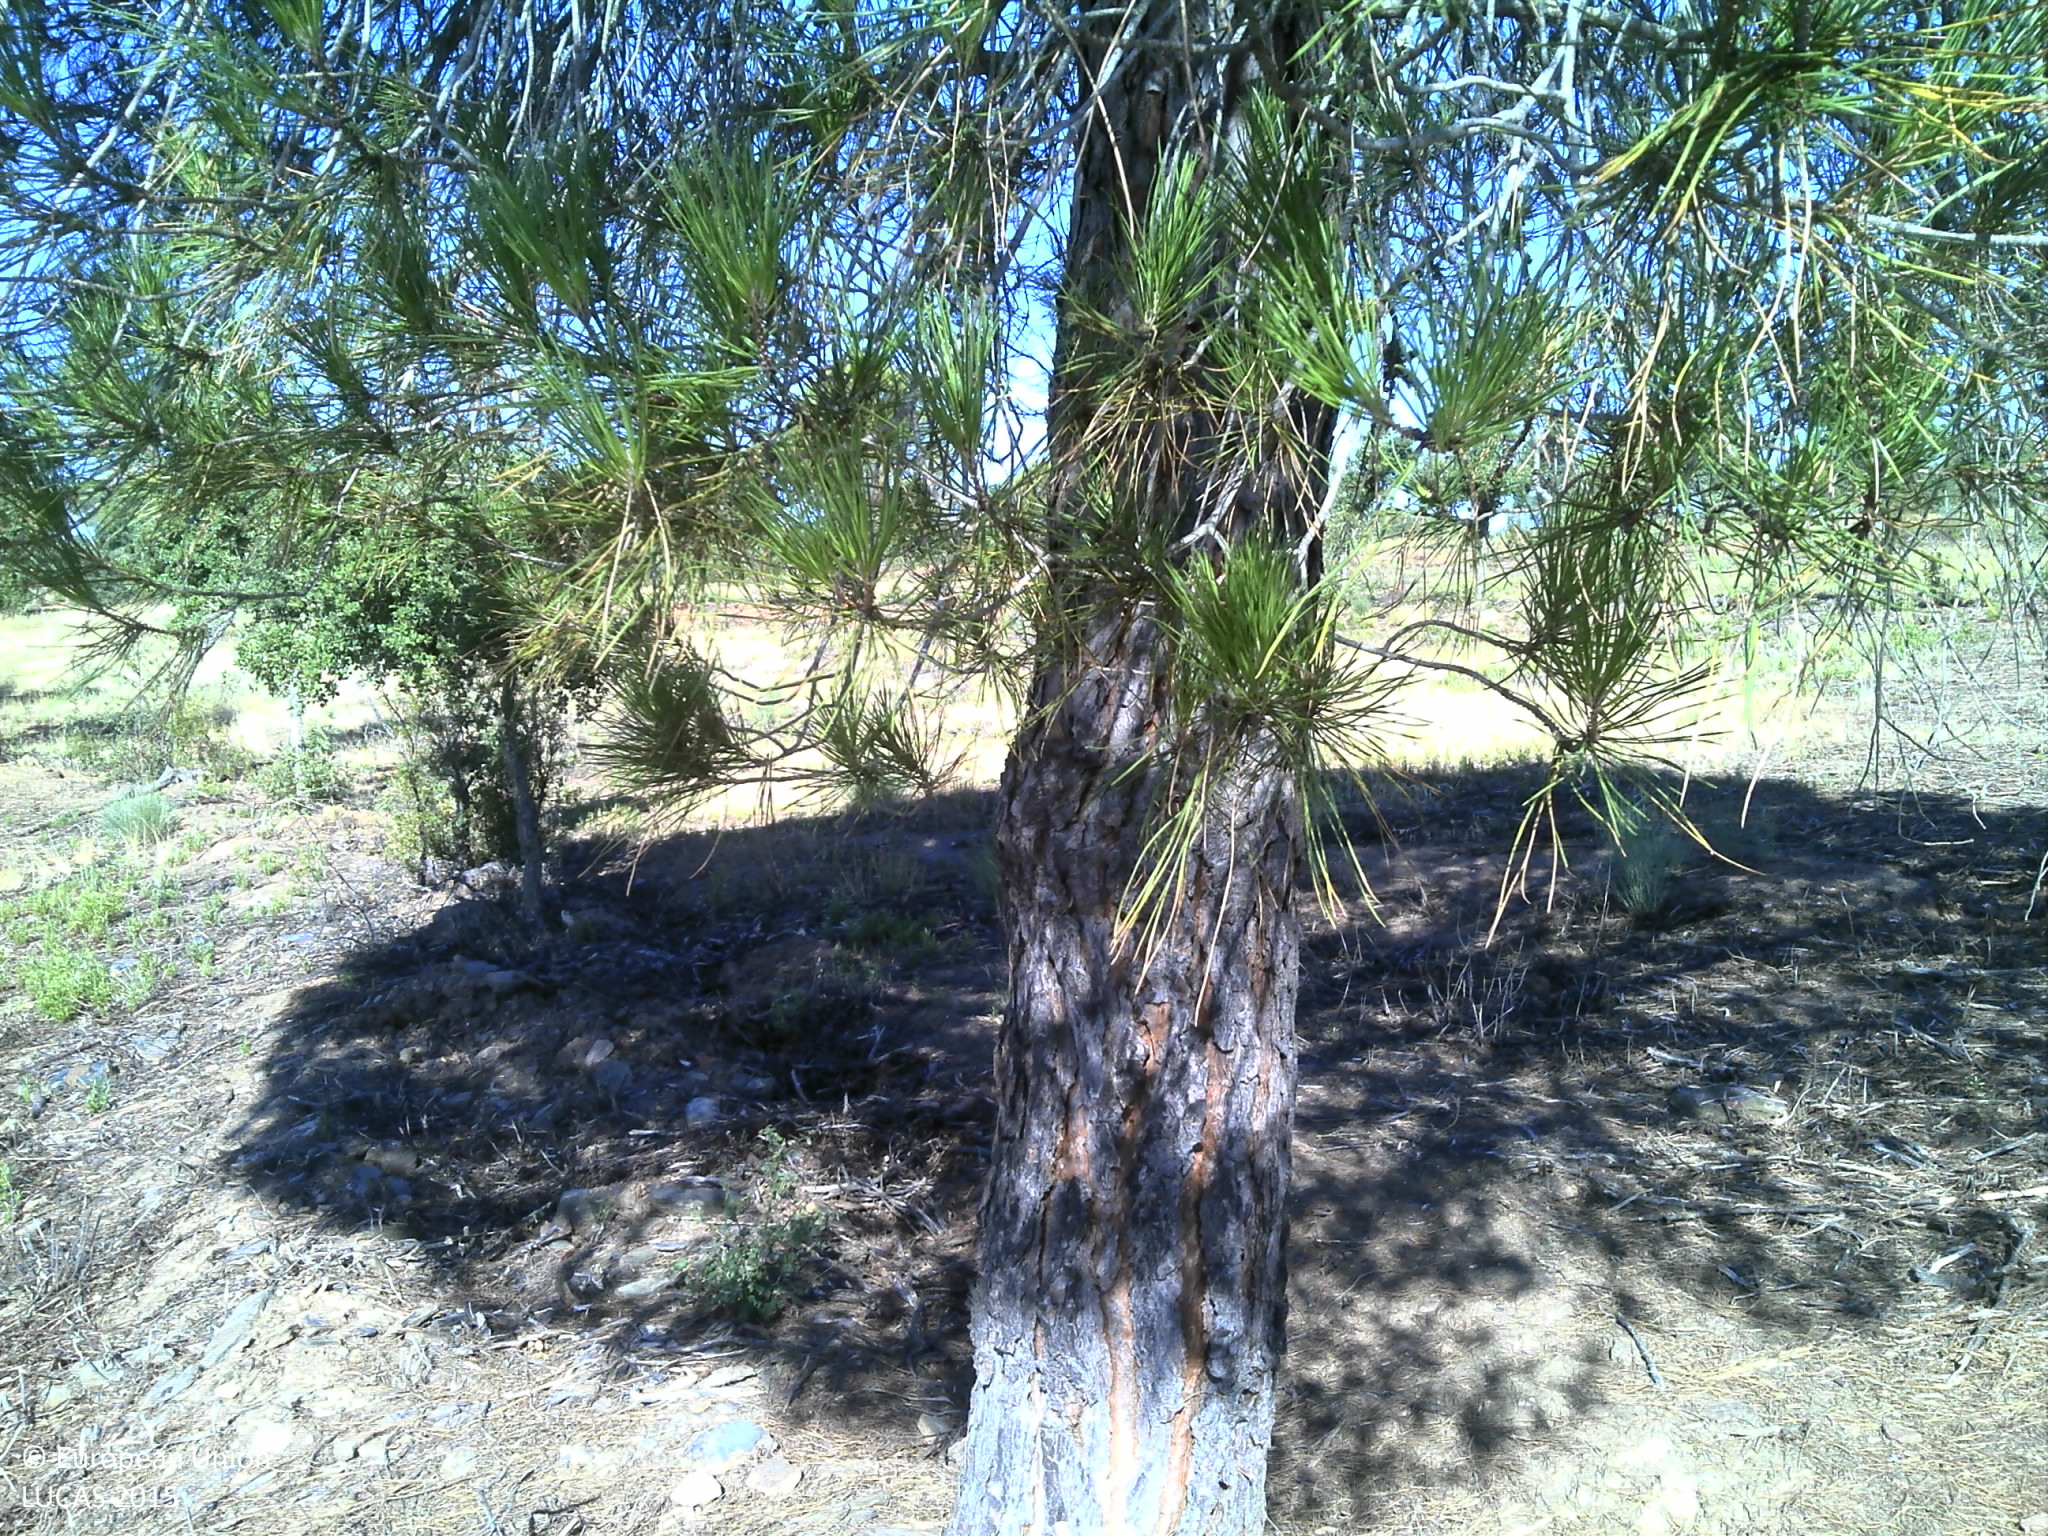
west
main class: Woodland
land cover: Pine dominated coniferous woodland
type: coniferous forest of the mediterranean region
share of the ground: 10 - 25 %
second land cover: Grassland without tree/shrub cover
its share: 25 - 50 %
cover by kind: unconsolidated bare surface 55 %, coniferous forest trees 25 %, herbaceous plants 20 %
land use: Forestry
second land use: Agriculture (excluding fallow land and kitchen gardens)
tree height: > 5 m
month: July
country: PT
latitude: 38.9364
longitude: -7.5146
